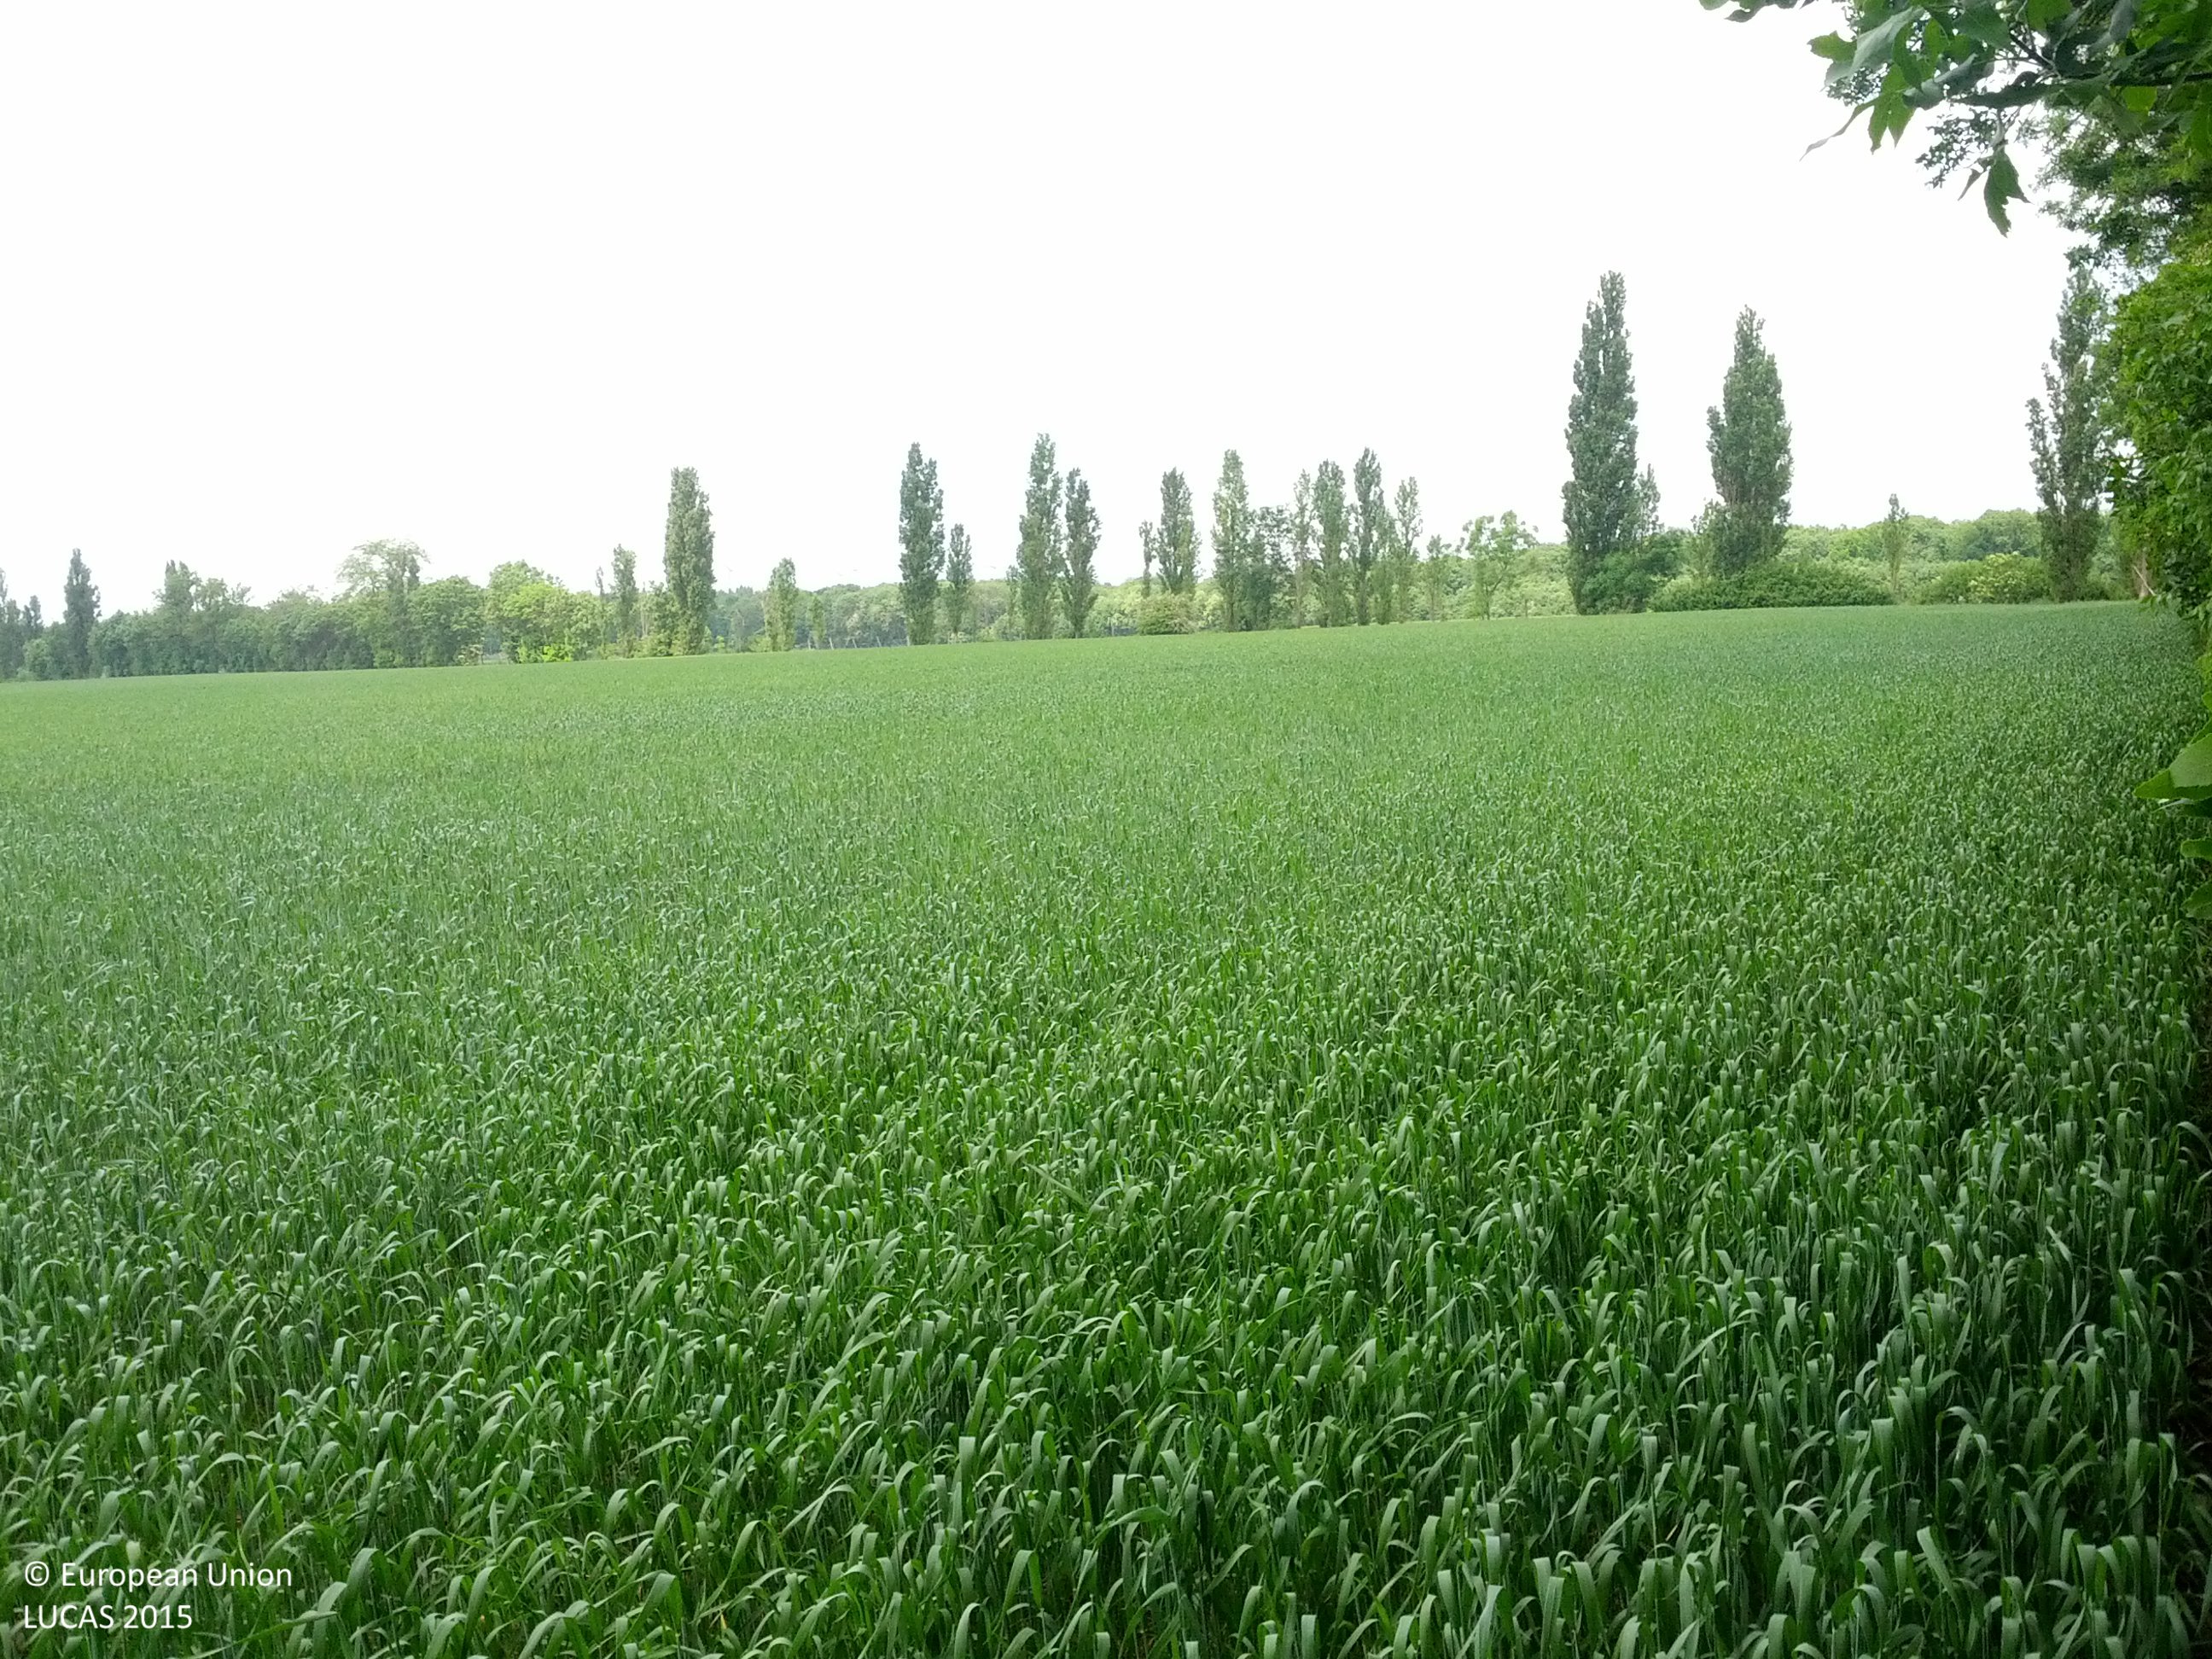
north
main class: Cropland
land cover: Common wheat
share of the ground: > 75 %
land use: Agriculture (excluding fallow land and kitchen gardens)
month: May
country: AT
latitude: 48.0458
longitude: 16.8614
